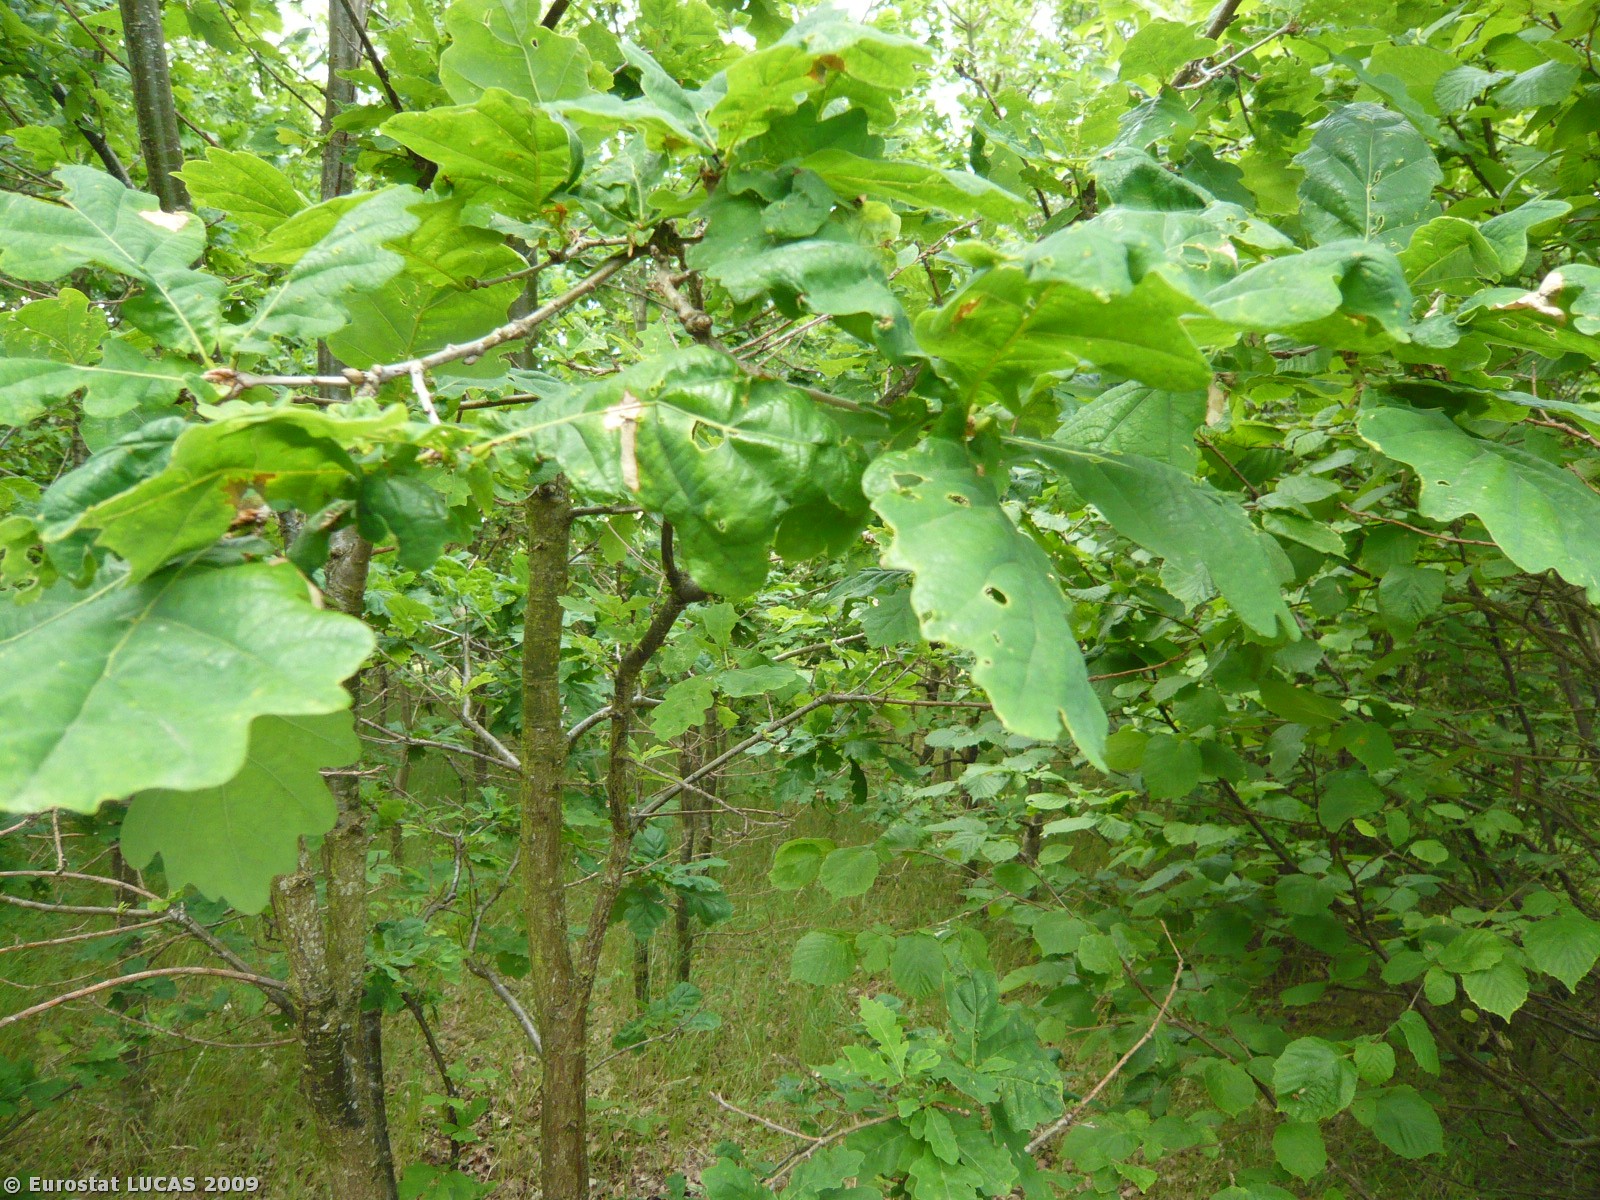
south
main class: Woodland
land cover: Broadleaved woodland
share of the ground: > 75 %
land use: Forestry
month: June
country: DK
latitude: 55.1991
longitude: 10.1413
